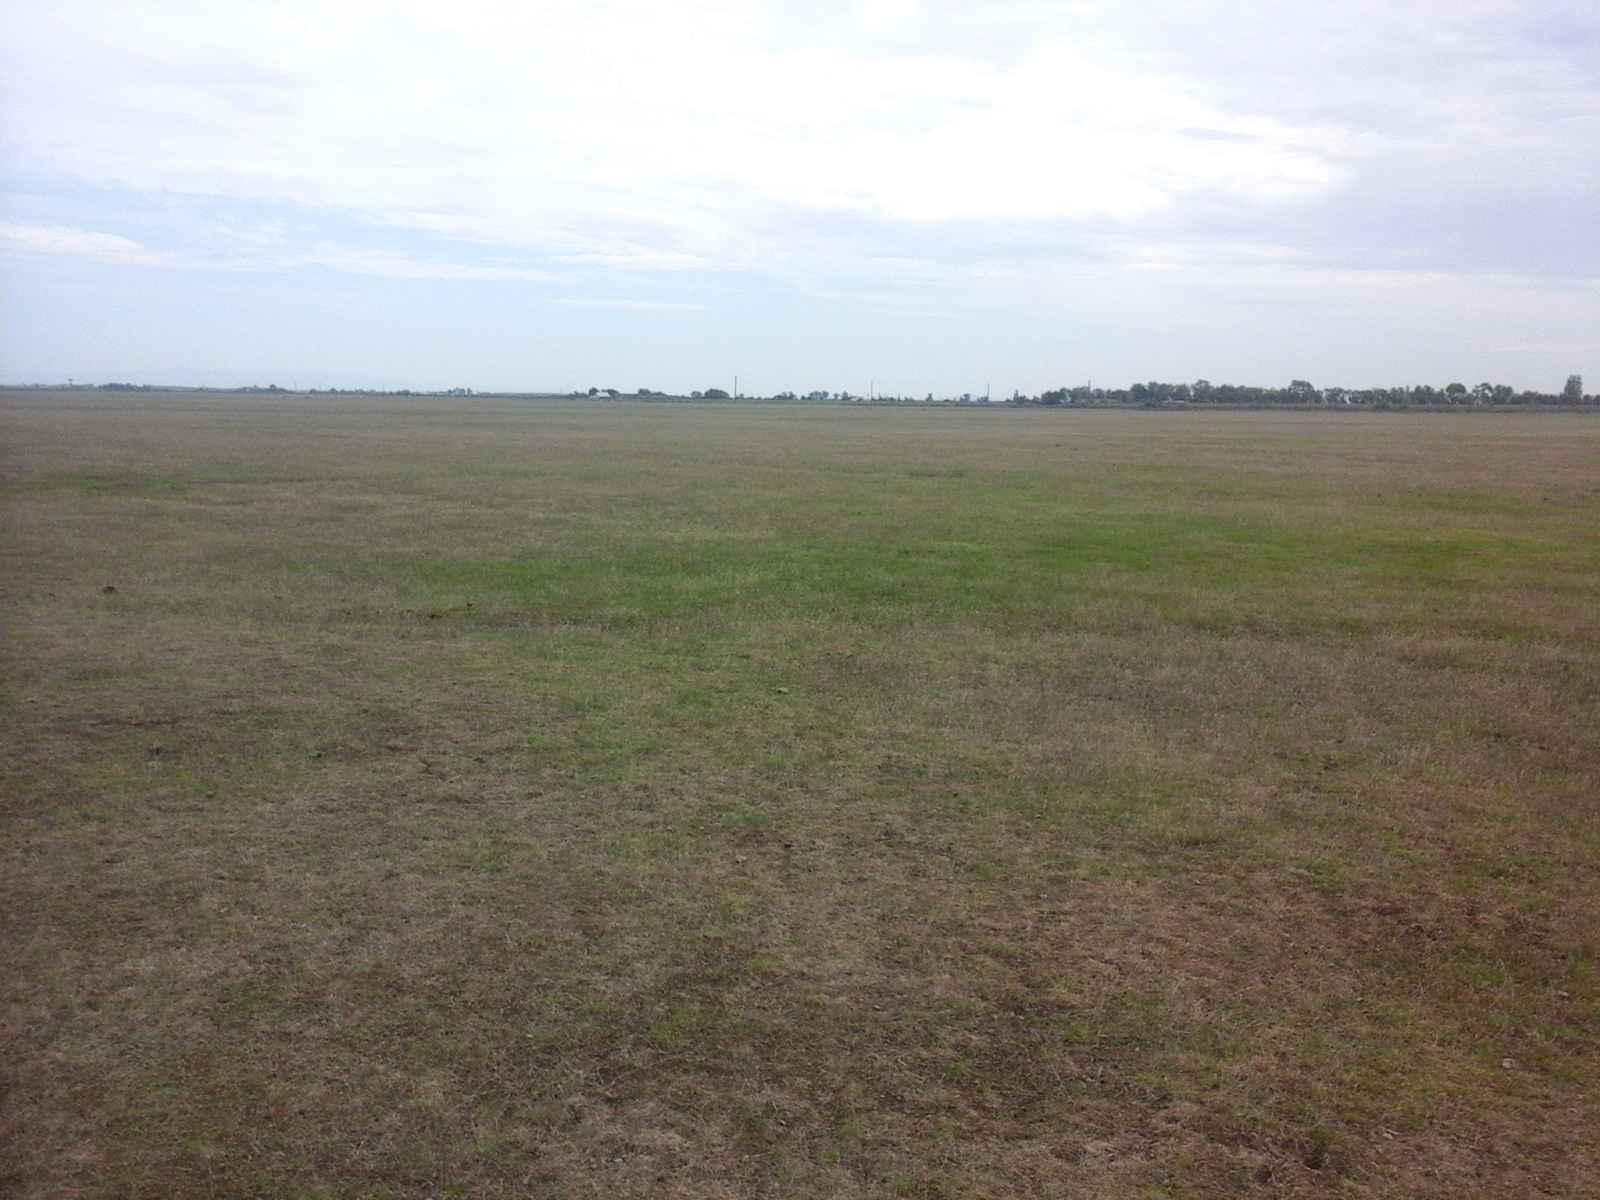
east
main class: Grassland
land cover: Grassland without tree/shrub cover
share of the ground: > 75 %
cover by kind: herbaceous plants 100 %
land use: Agriculture (excluding fallow land and kitchen gardens)
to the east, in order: Grassland without tree/shrub cover
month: August
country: RO
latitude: 46.5168
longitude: 21.4422
